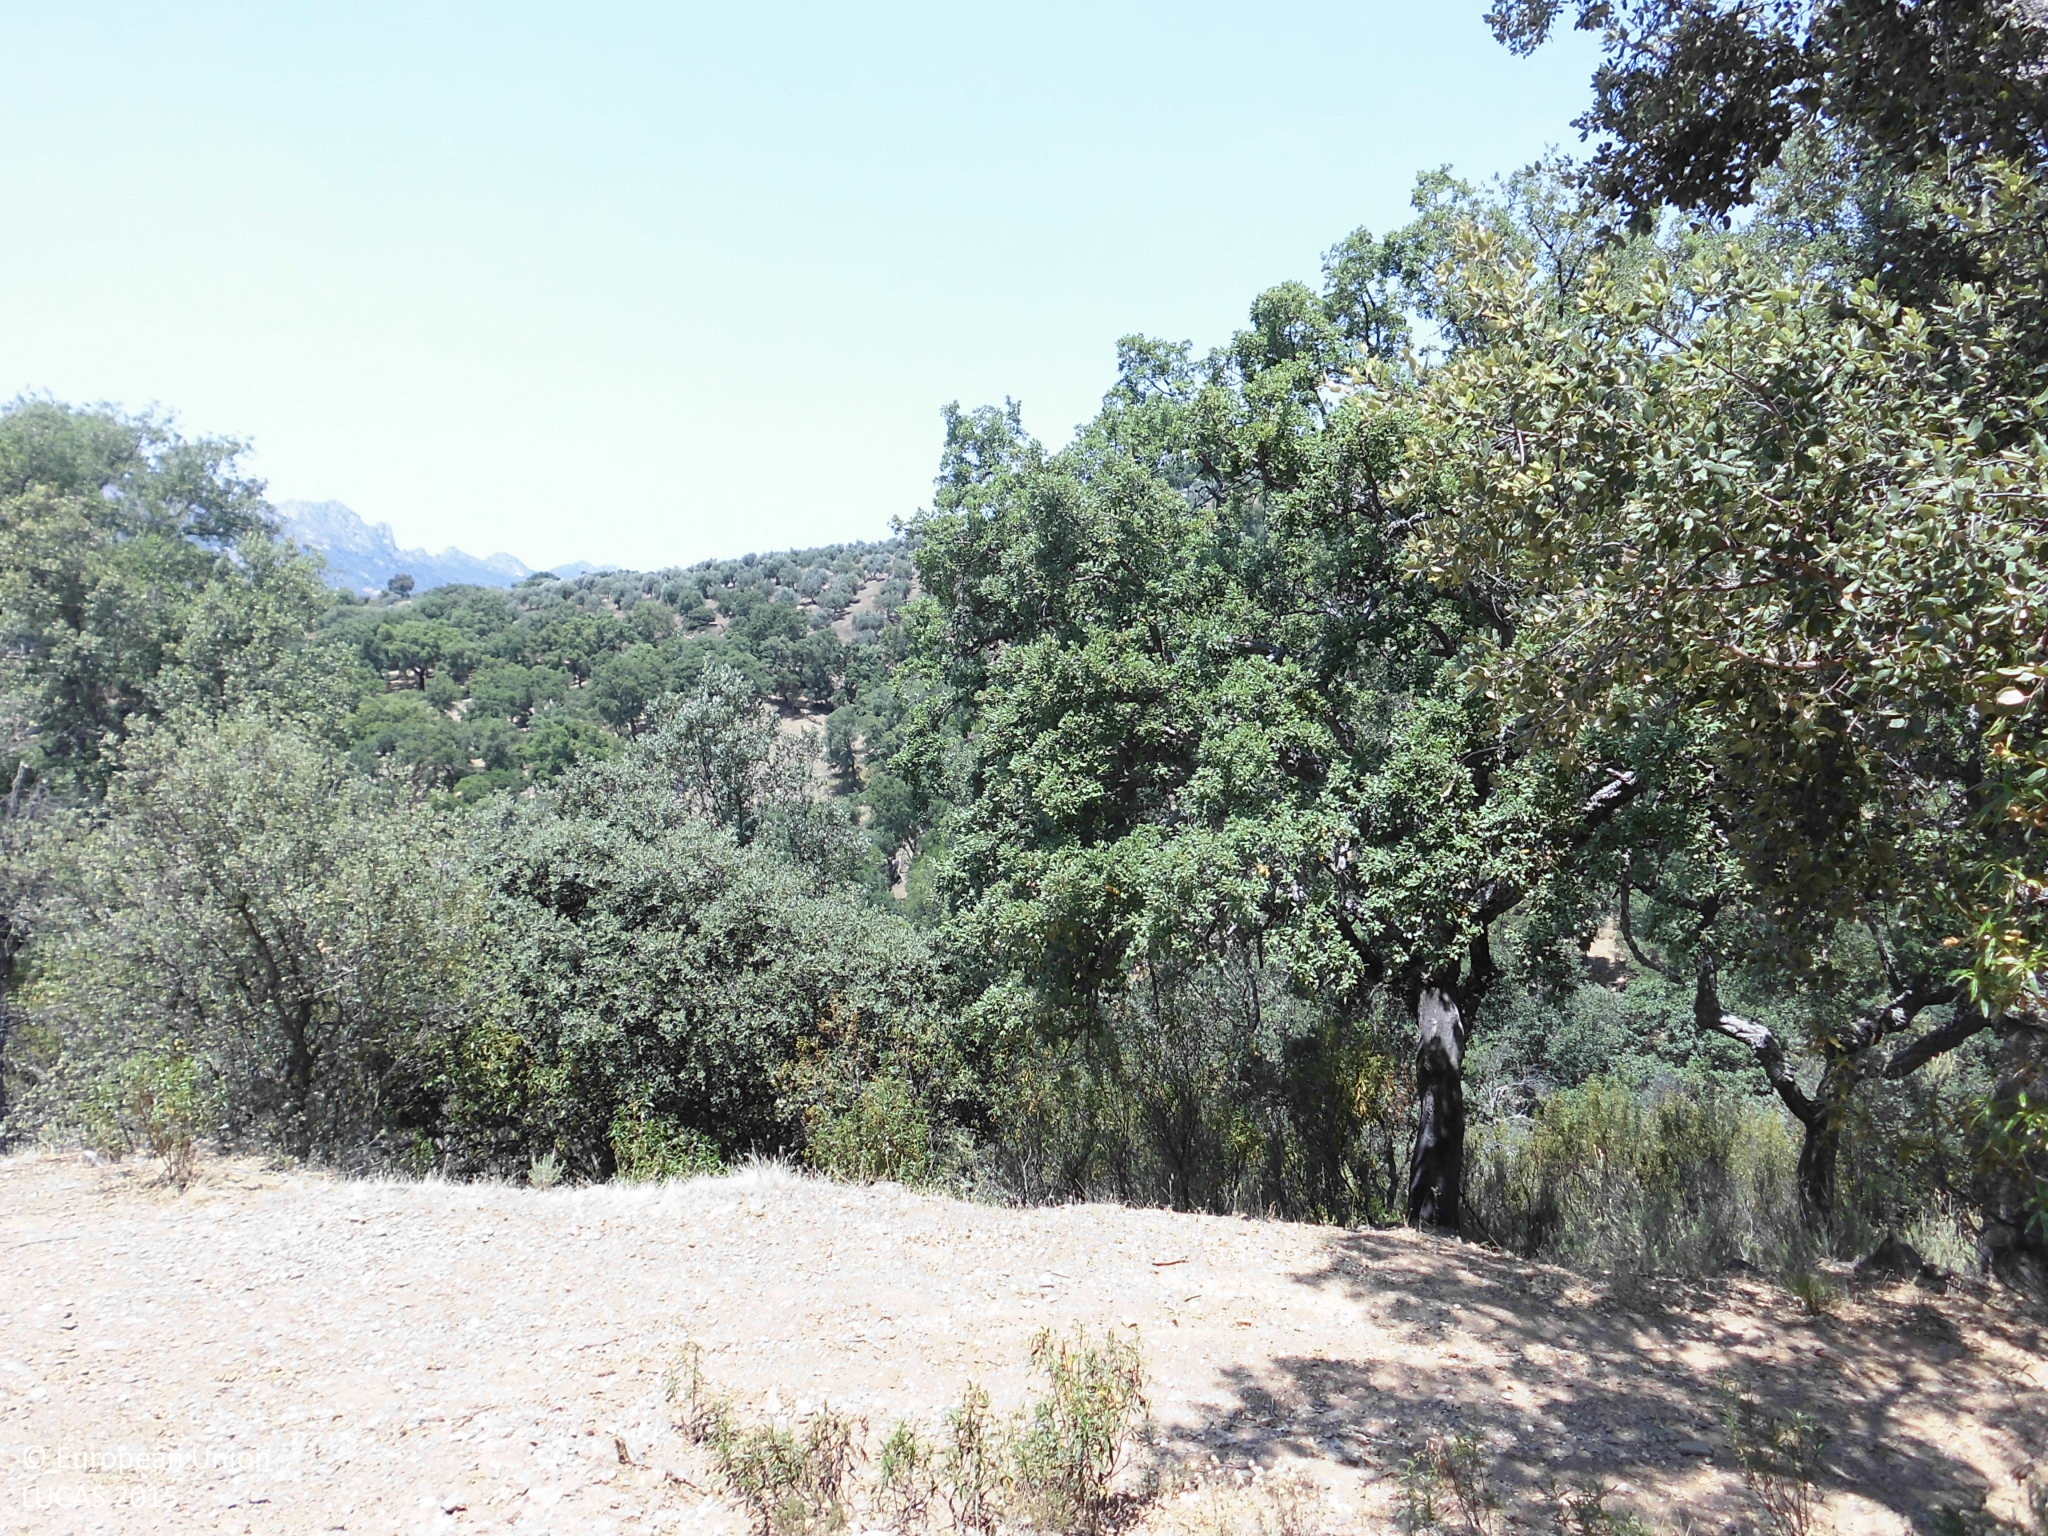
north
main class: Woodland
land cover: Broadleaved woodland
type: broadleaved evergreen forest
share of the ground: 10 - 25 %
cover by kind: herbaceous plants 60 %, shrubs 25 %, broadleaved forest trees 15 %
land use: Forestry
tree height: > 5 m
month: June
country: ES
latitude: 39.5612
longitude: -5.3796
